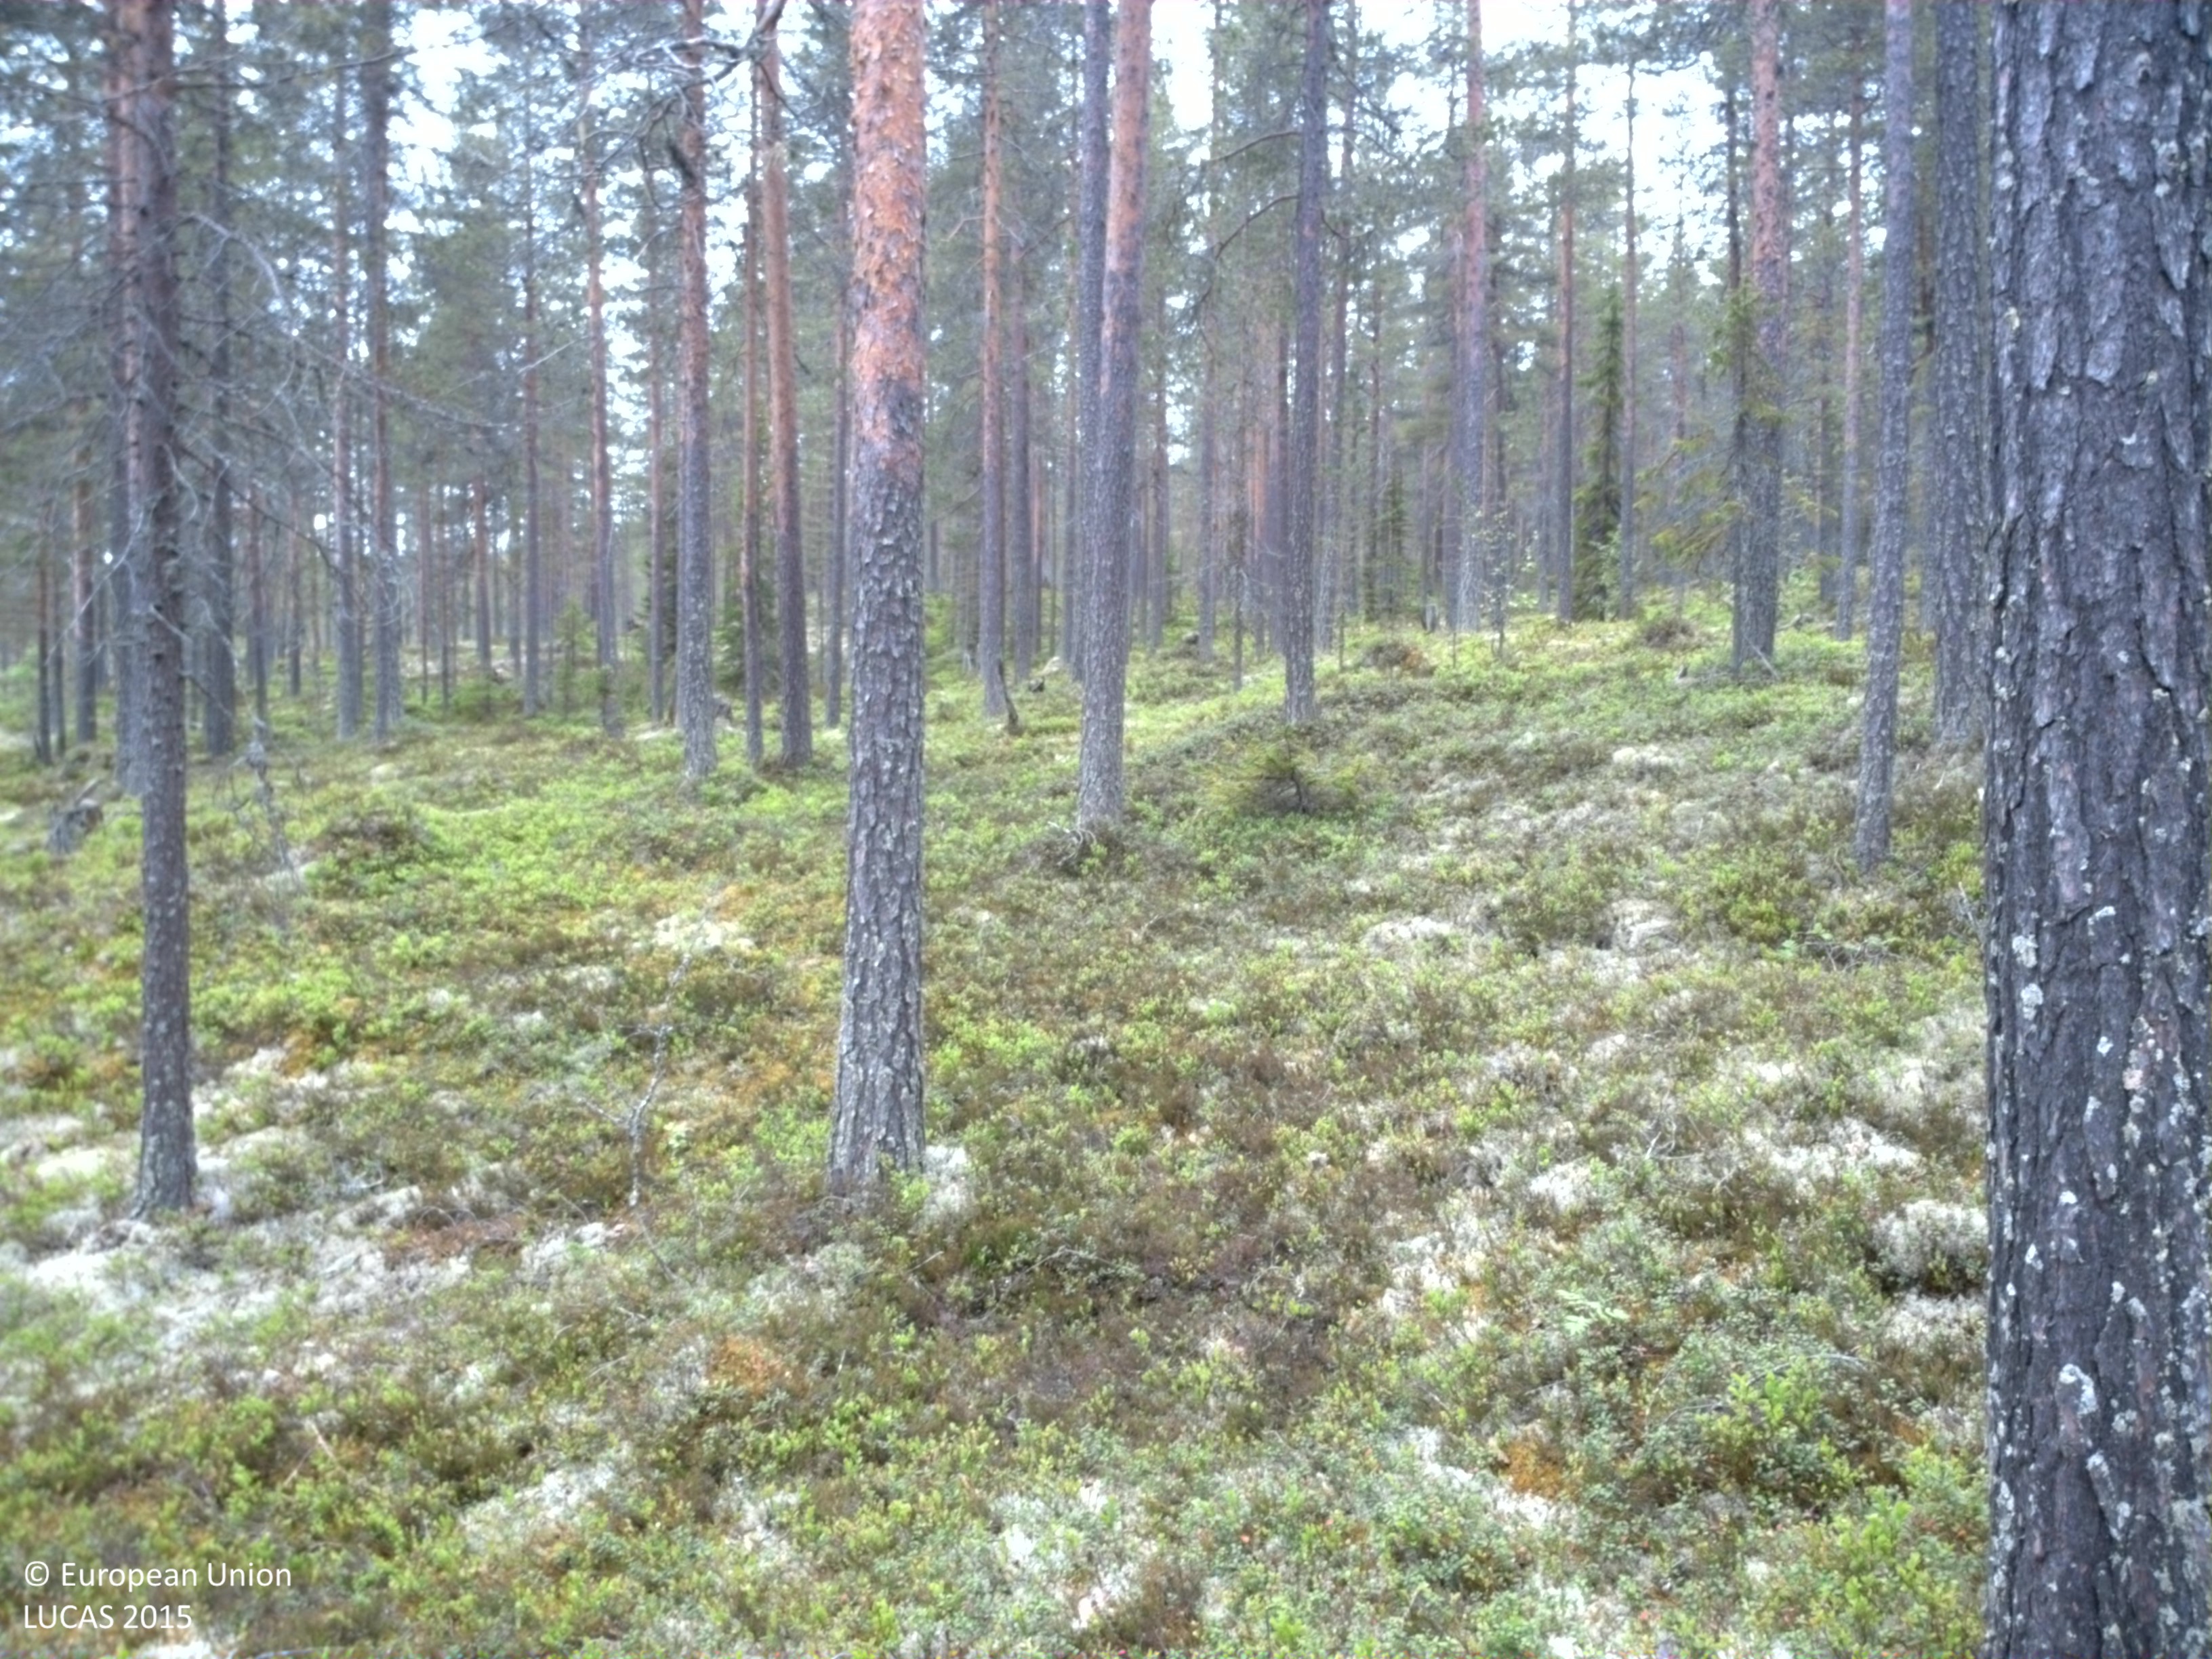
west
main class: Woodland
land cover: Pine dominated coniferous woodland
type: boreal forest
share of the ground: 50 - 75 %
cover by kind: coniferous forest trees 60 %, lichens and mosses 25 %, herbaceous plants 15 %
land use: Forestry
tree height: > 5 m
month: June
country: SE
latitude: 61.4496
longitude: 13.6446
